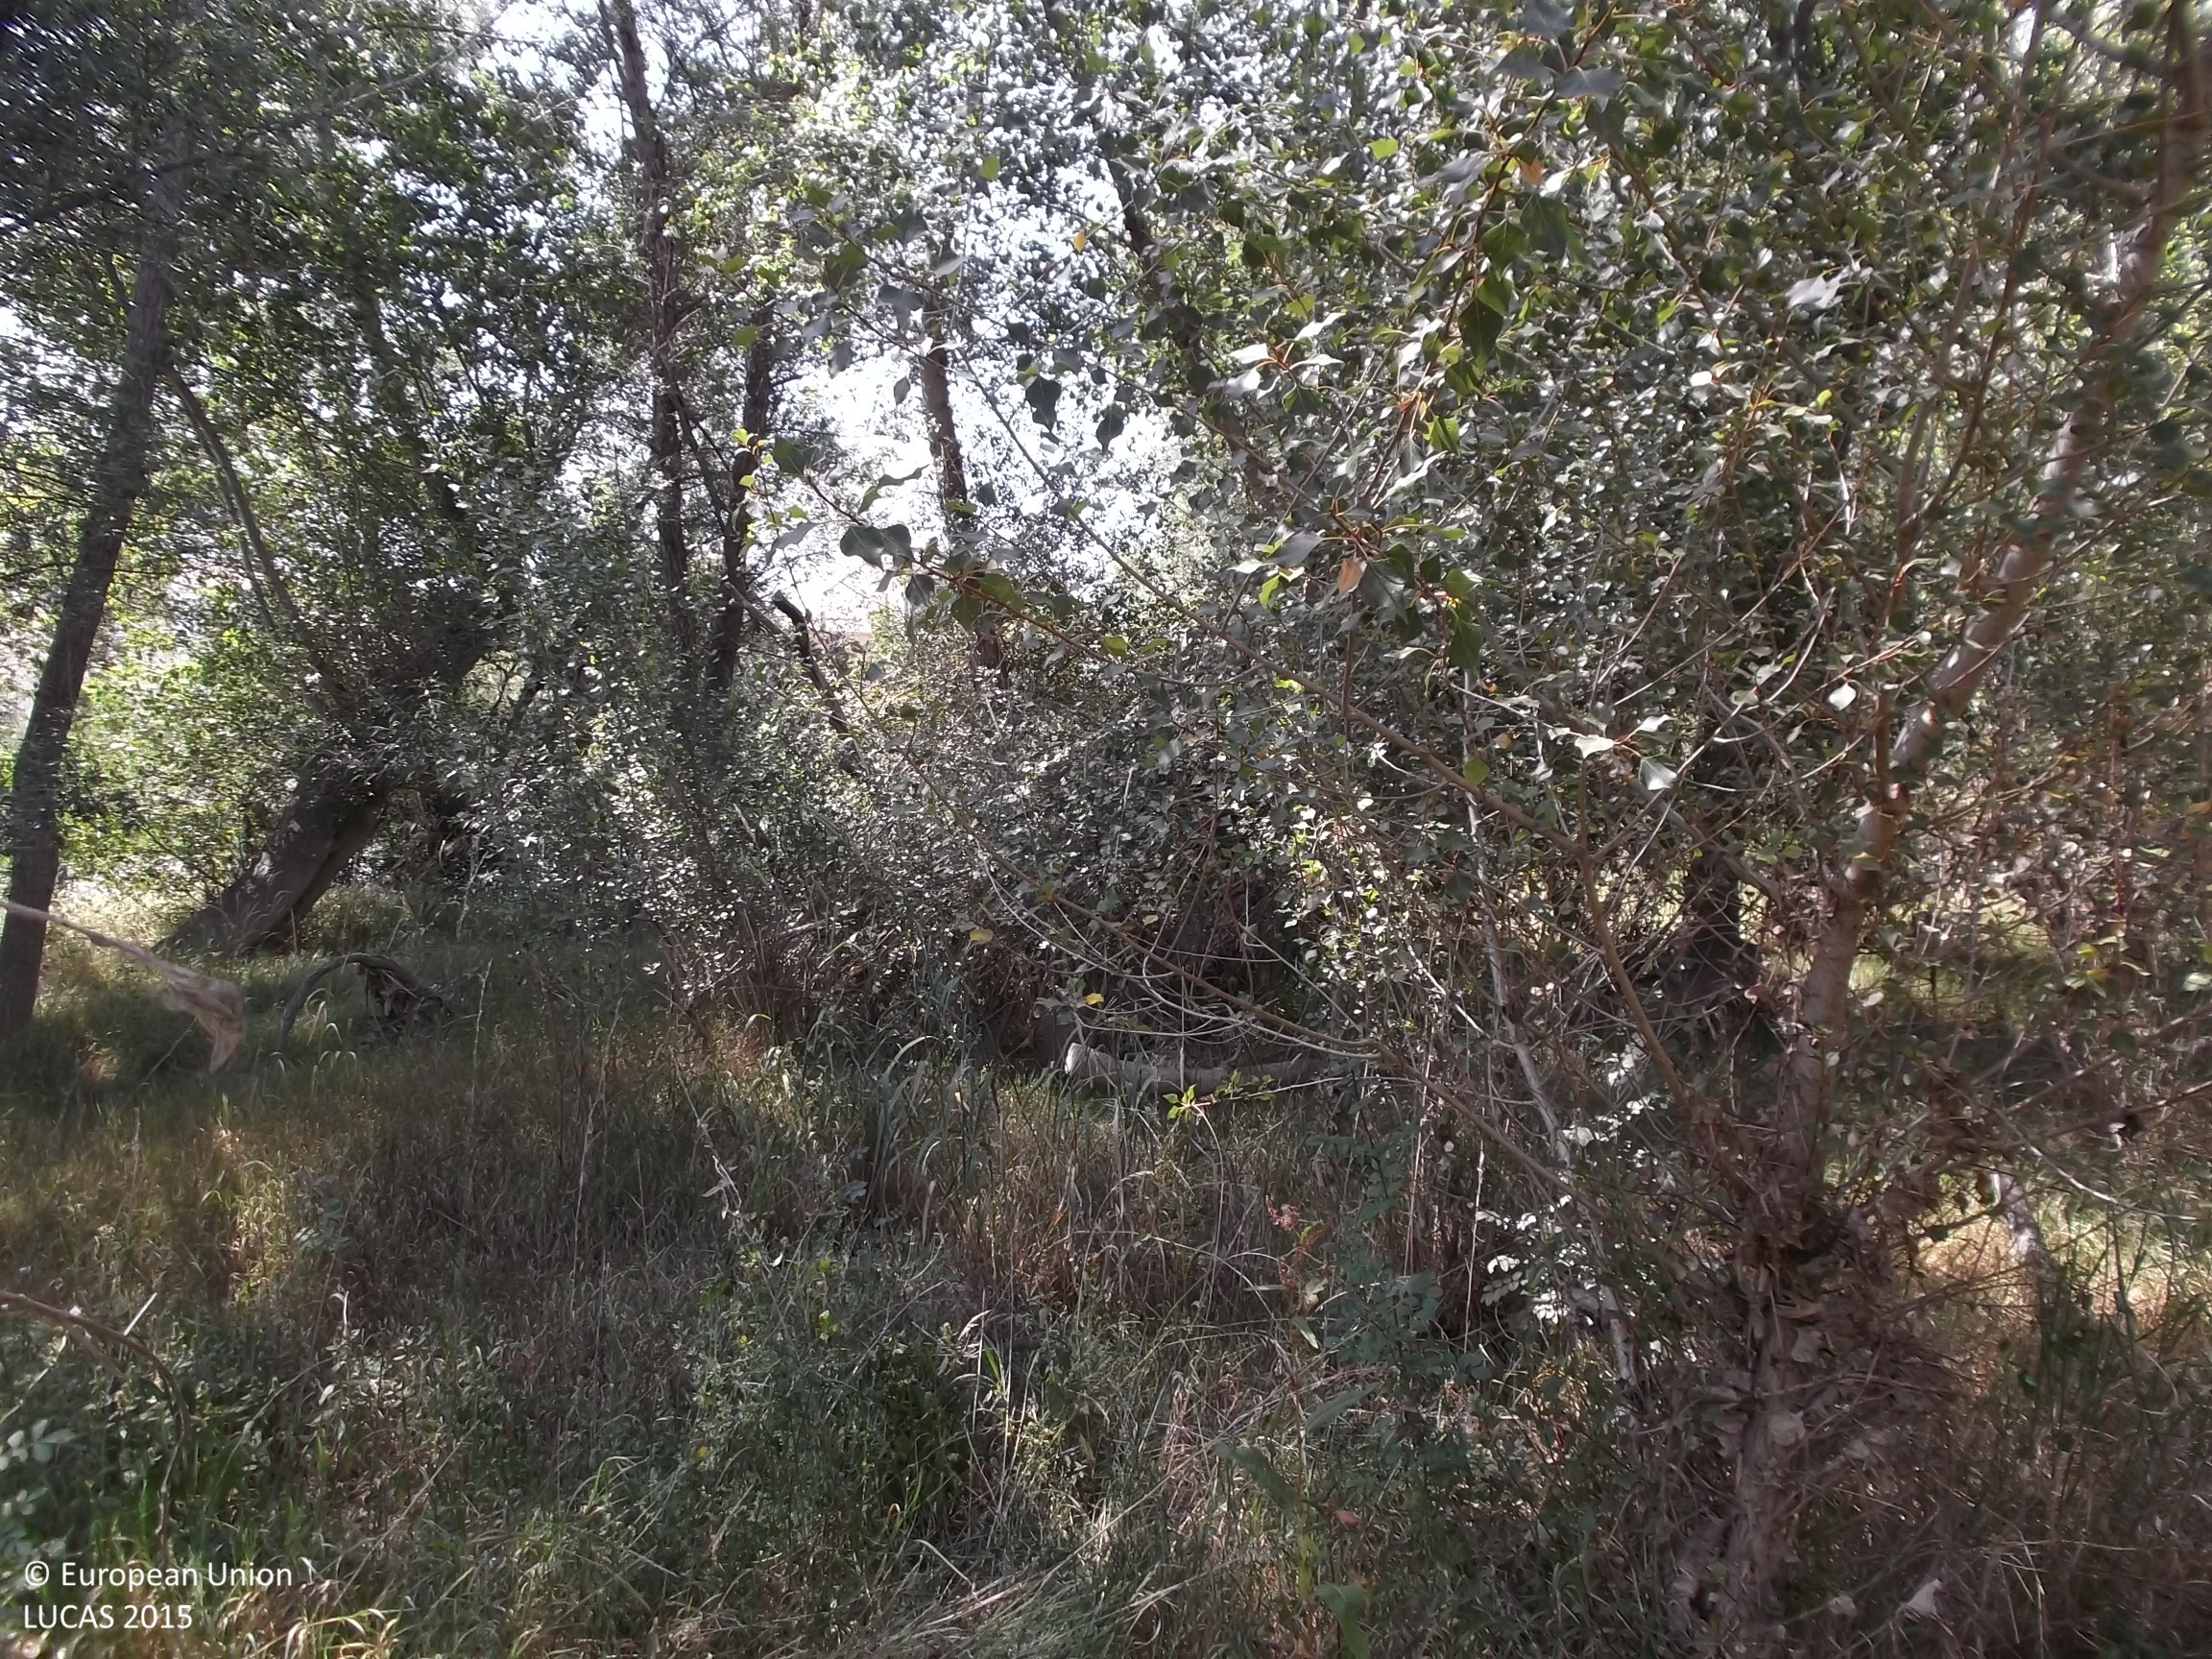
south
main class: Woodland
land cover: Broadleaved woodland
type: floodplain forest
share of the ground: > 75 %
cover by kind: broadleaved forest trees 80 %, herbaceous plants 20 %
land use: Semi-natural and natural areas not in use
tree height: > 5 m
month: July
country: ES
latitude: 42.3437
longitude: -1.6513
